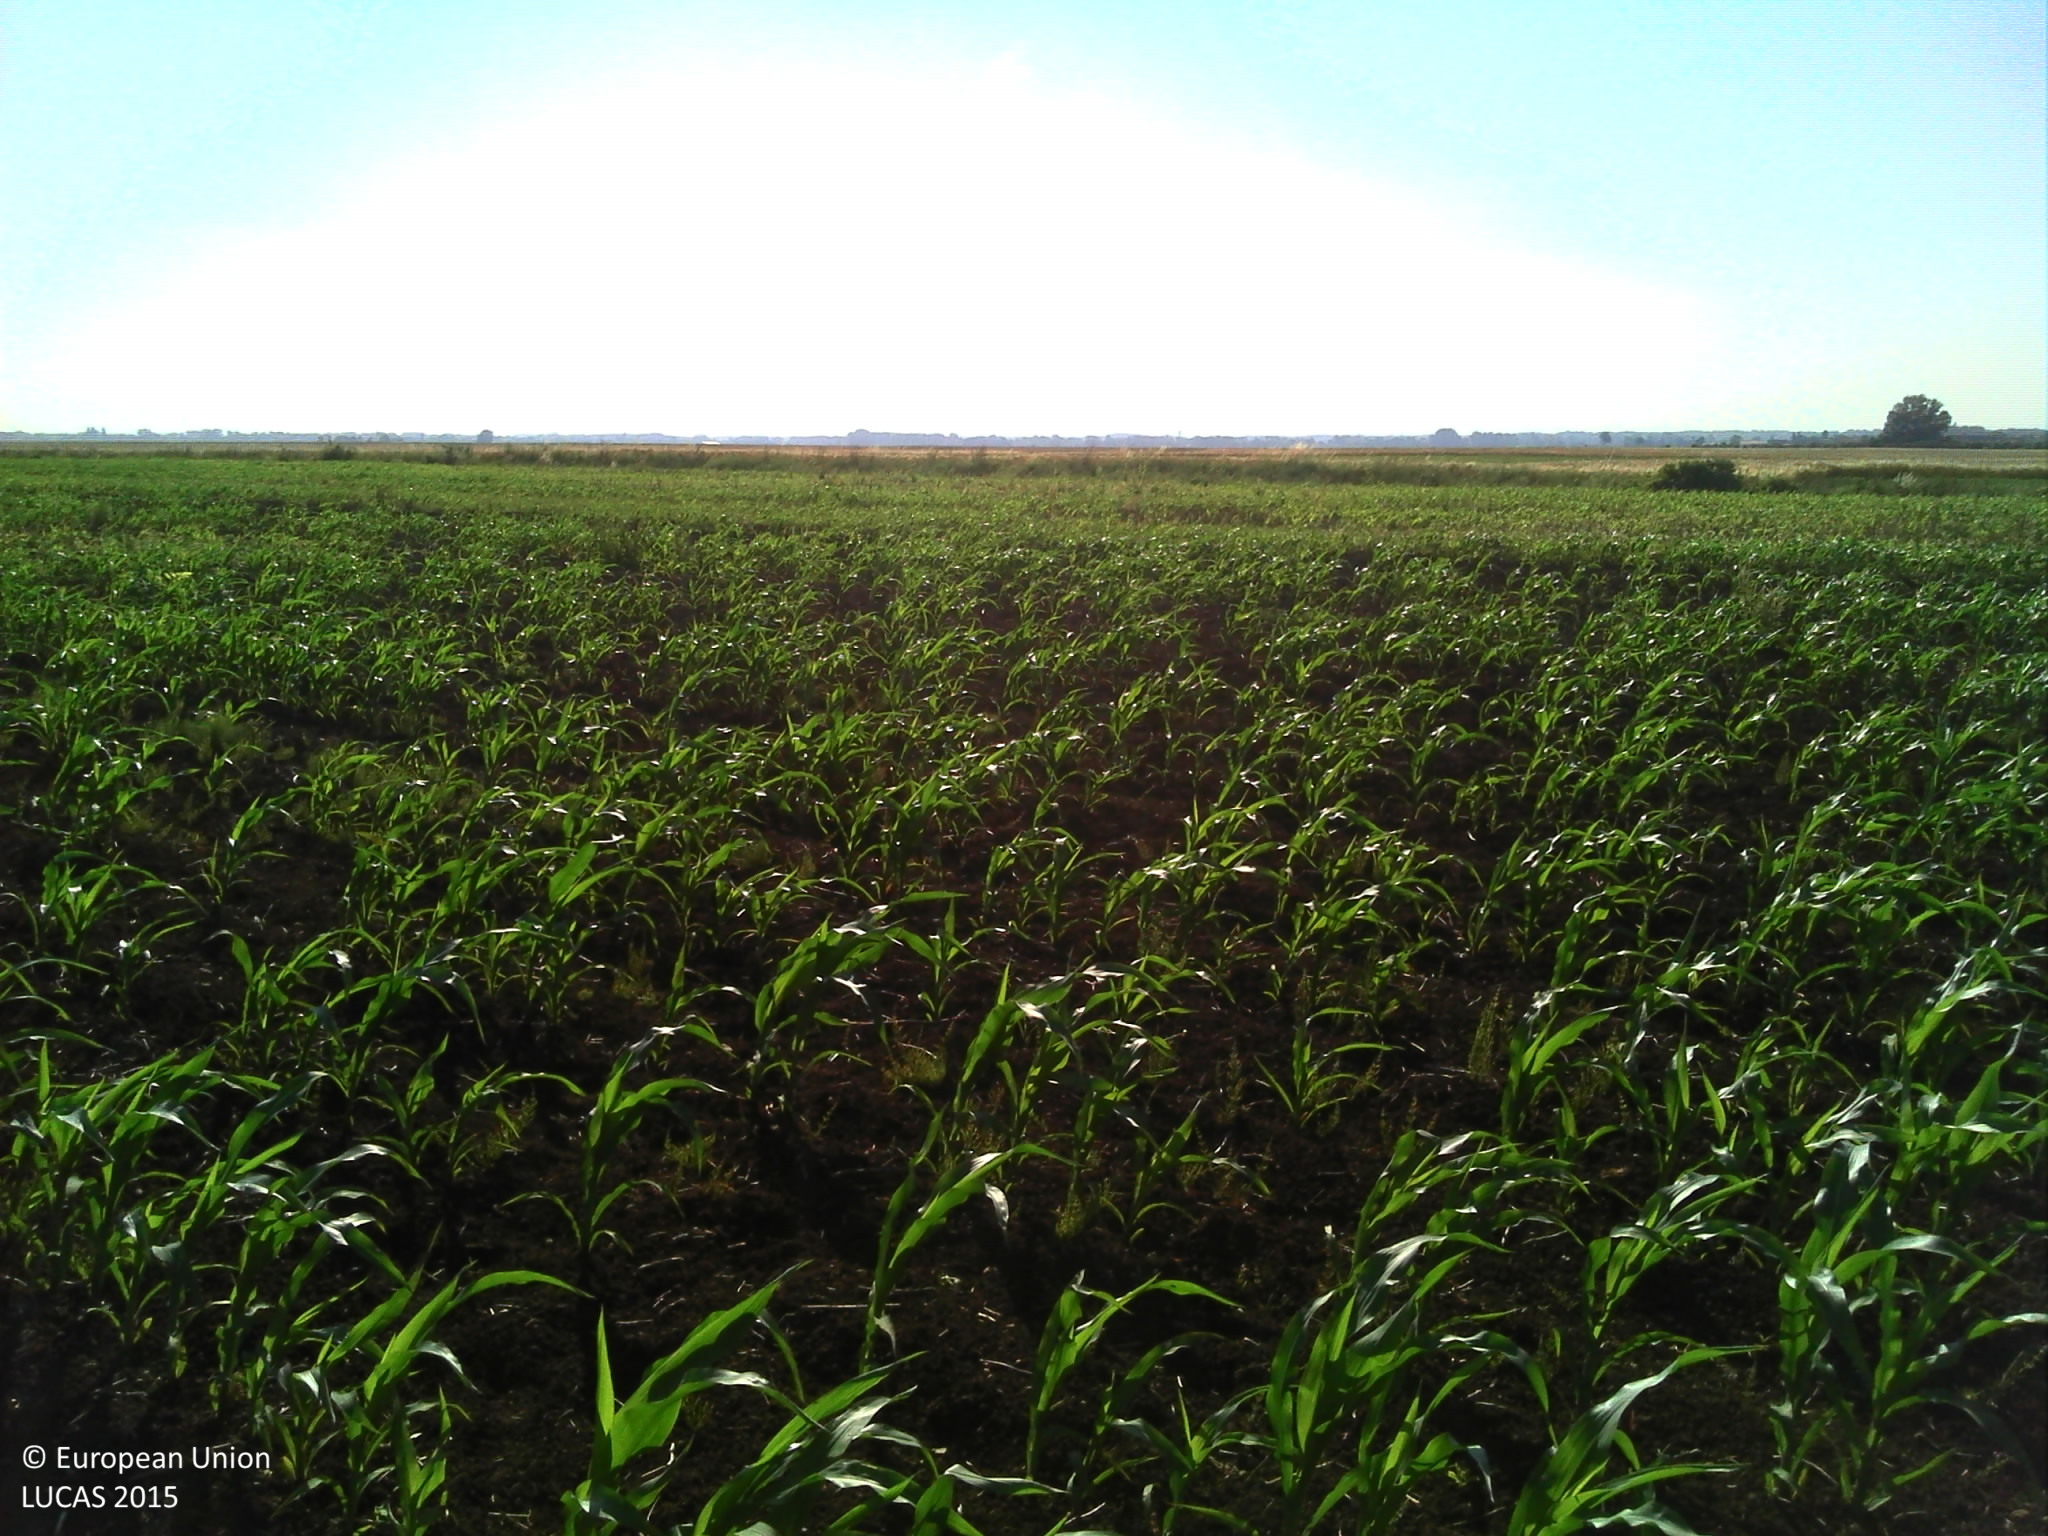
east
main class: Cropland
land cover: Maize
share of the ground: 25 - 50 %
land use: Agriculture (excluding fallow land and kitchen gardens)
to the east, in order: Maize; Grass margins; Ditches and canals; Grass margins; Barley; Soya; Barley
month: June
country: FR
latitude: 46.9519
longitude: 5.3108
